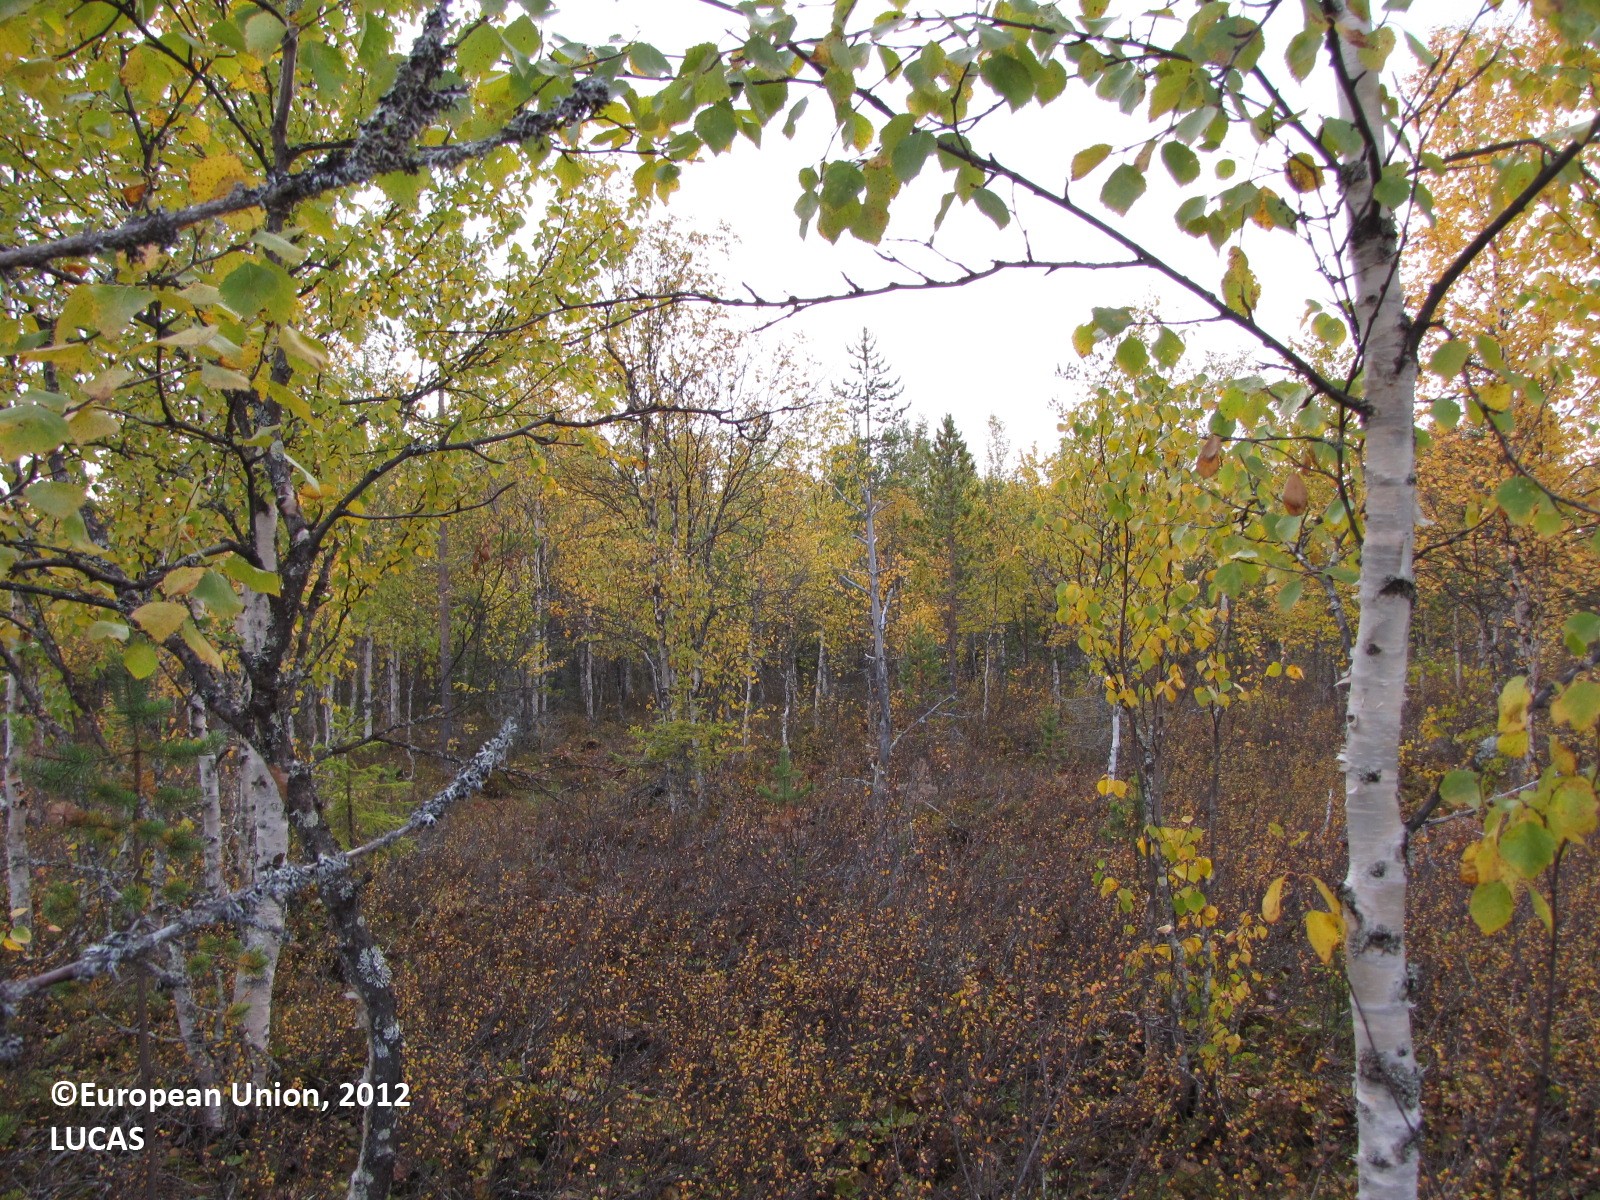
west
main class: Woodland
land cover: Pine dominated mixed woodland
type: boreal forest
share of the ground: 25 - 50 %
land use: Forestry
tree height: > 5 m
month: September
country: FI
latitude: 67.3234
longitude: 25.4141
